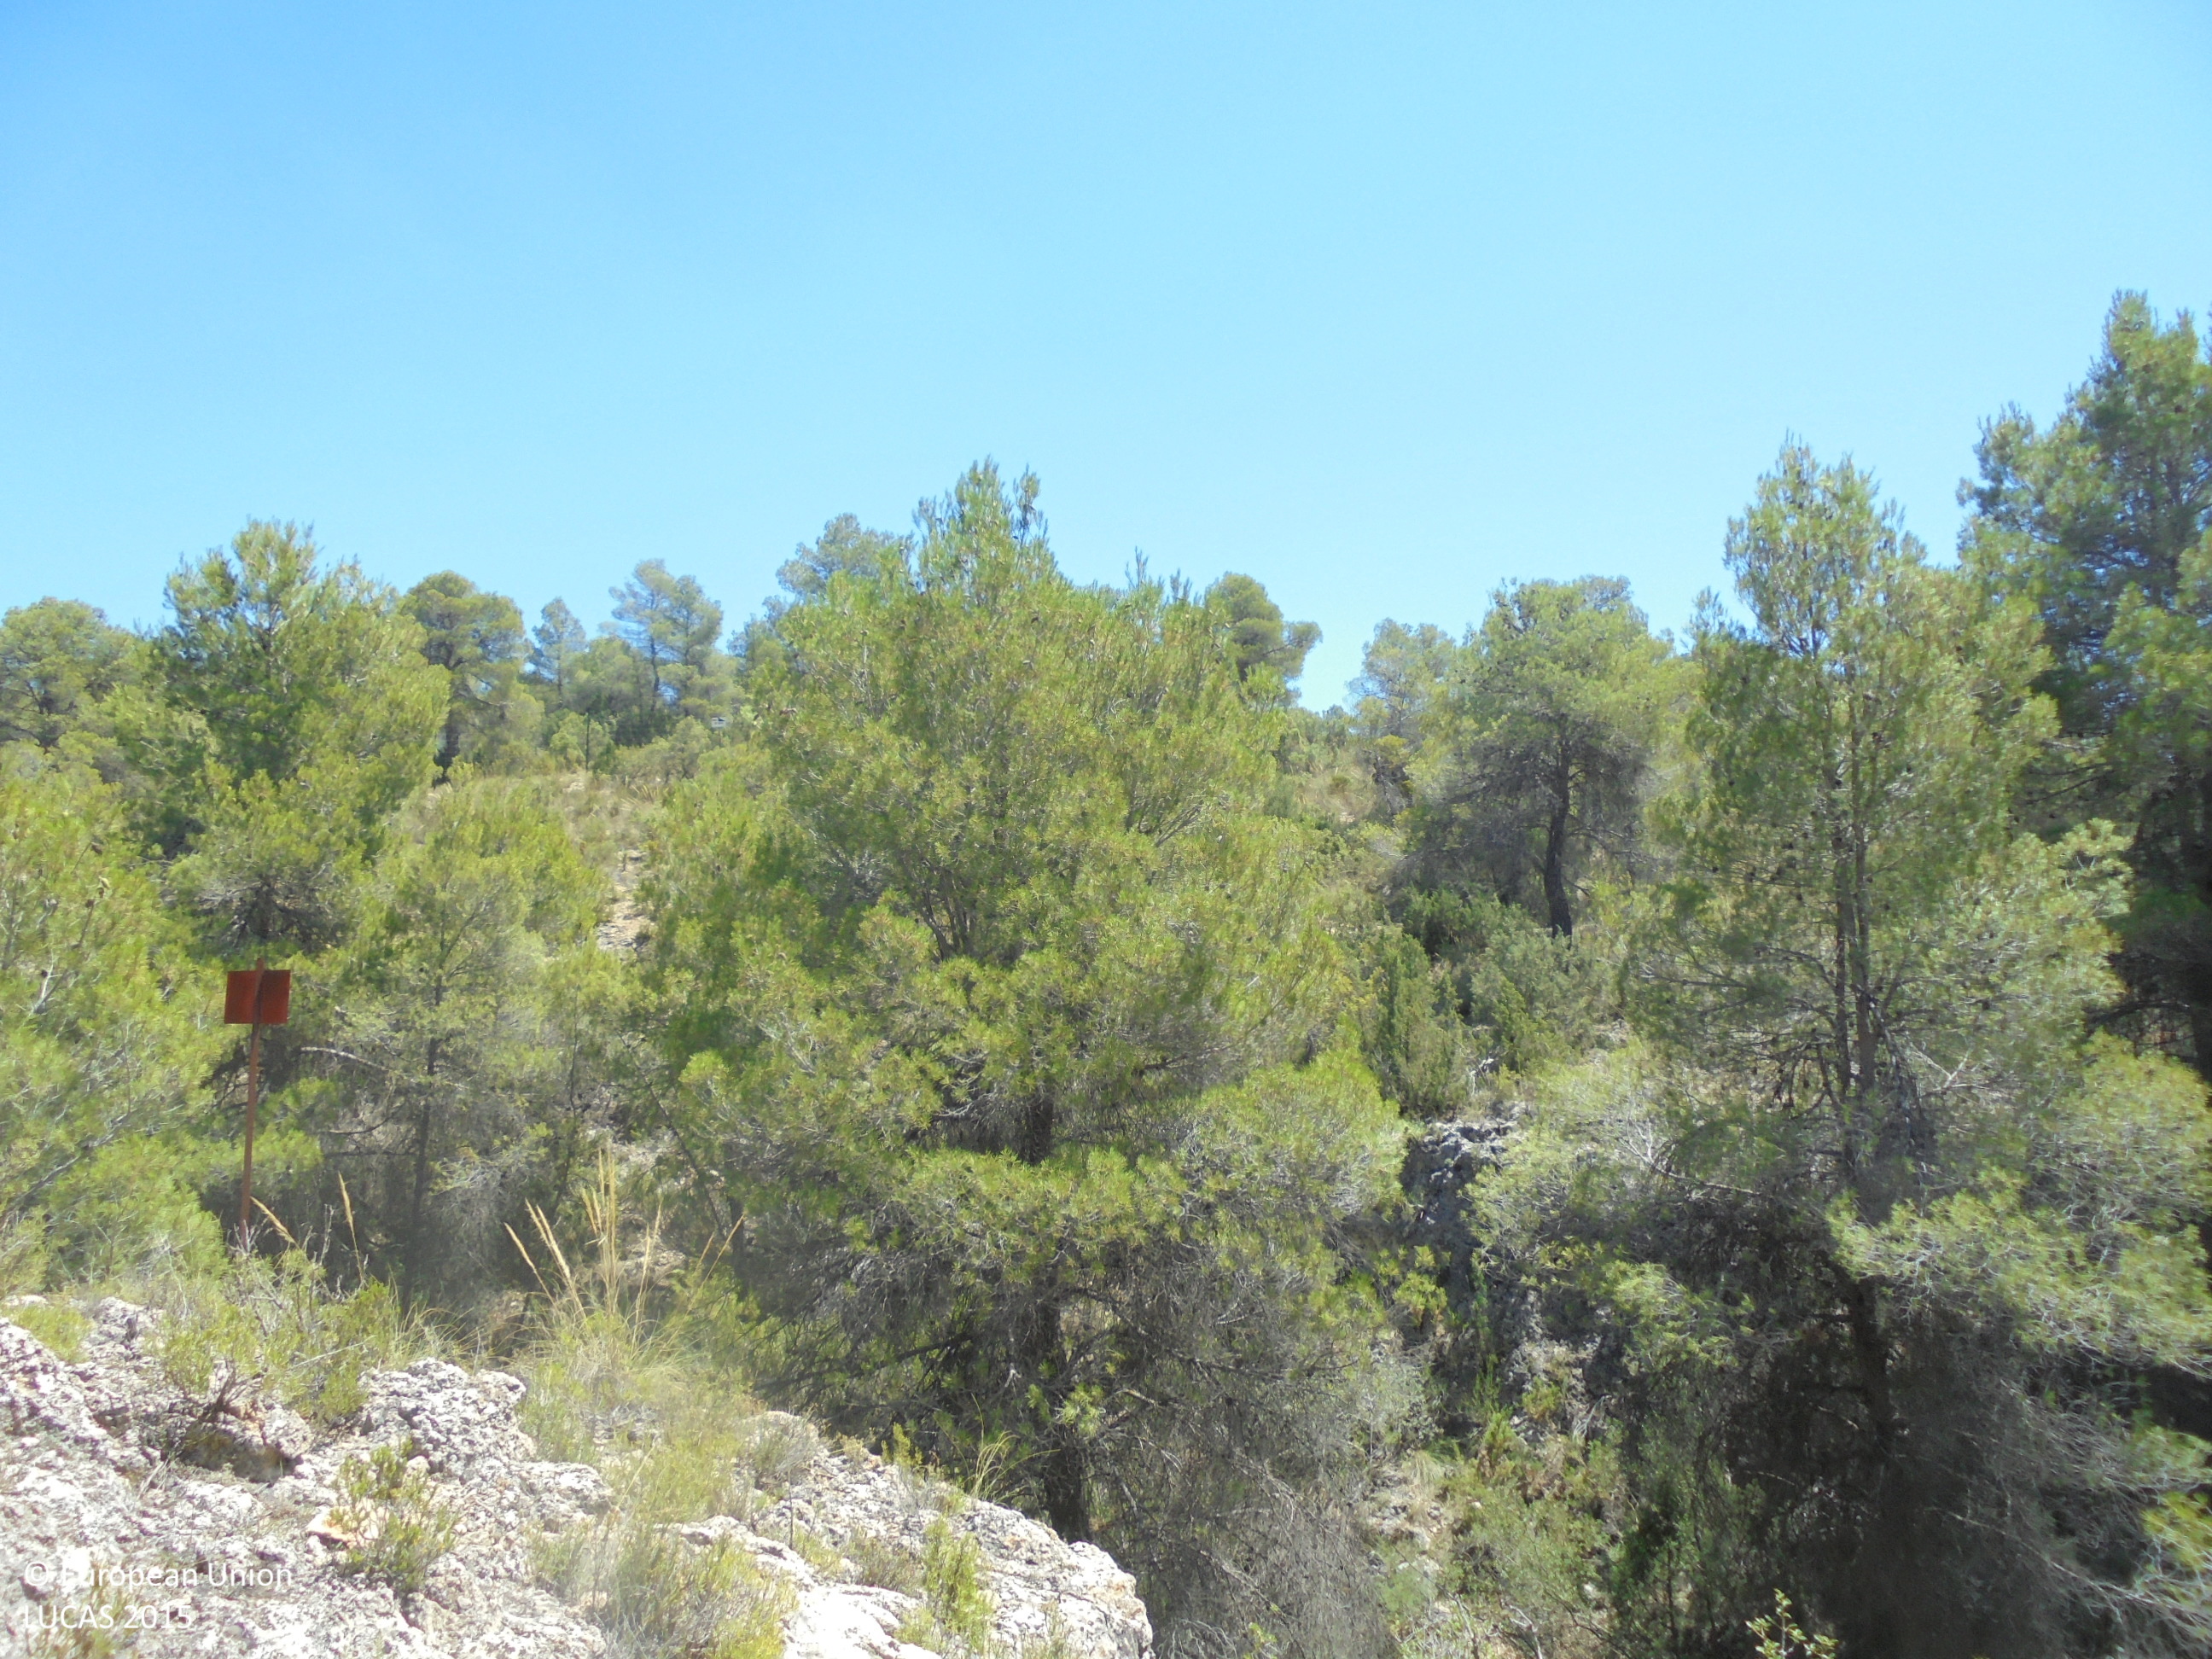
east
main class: Woodland
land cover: Pine dominated coniferous woodland
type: coniferous forest of the mediterranean region
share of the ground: 25 - 50 %
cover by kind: shrubs 50 %, coniferous forest trees 30 %, consolidated bare surface 10 %, unconsolidated bare surface 10 %
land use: Semi-natural and natural areas not in use
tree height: > 5 m
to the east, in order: Pine dominated coniferous woodland; Fences; Pine dominated coniferous woodland
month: July
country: ES
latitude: 38.9669
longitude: -1.0400
